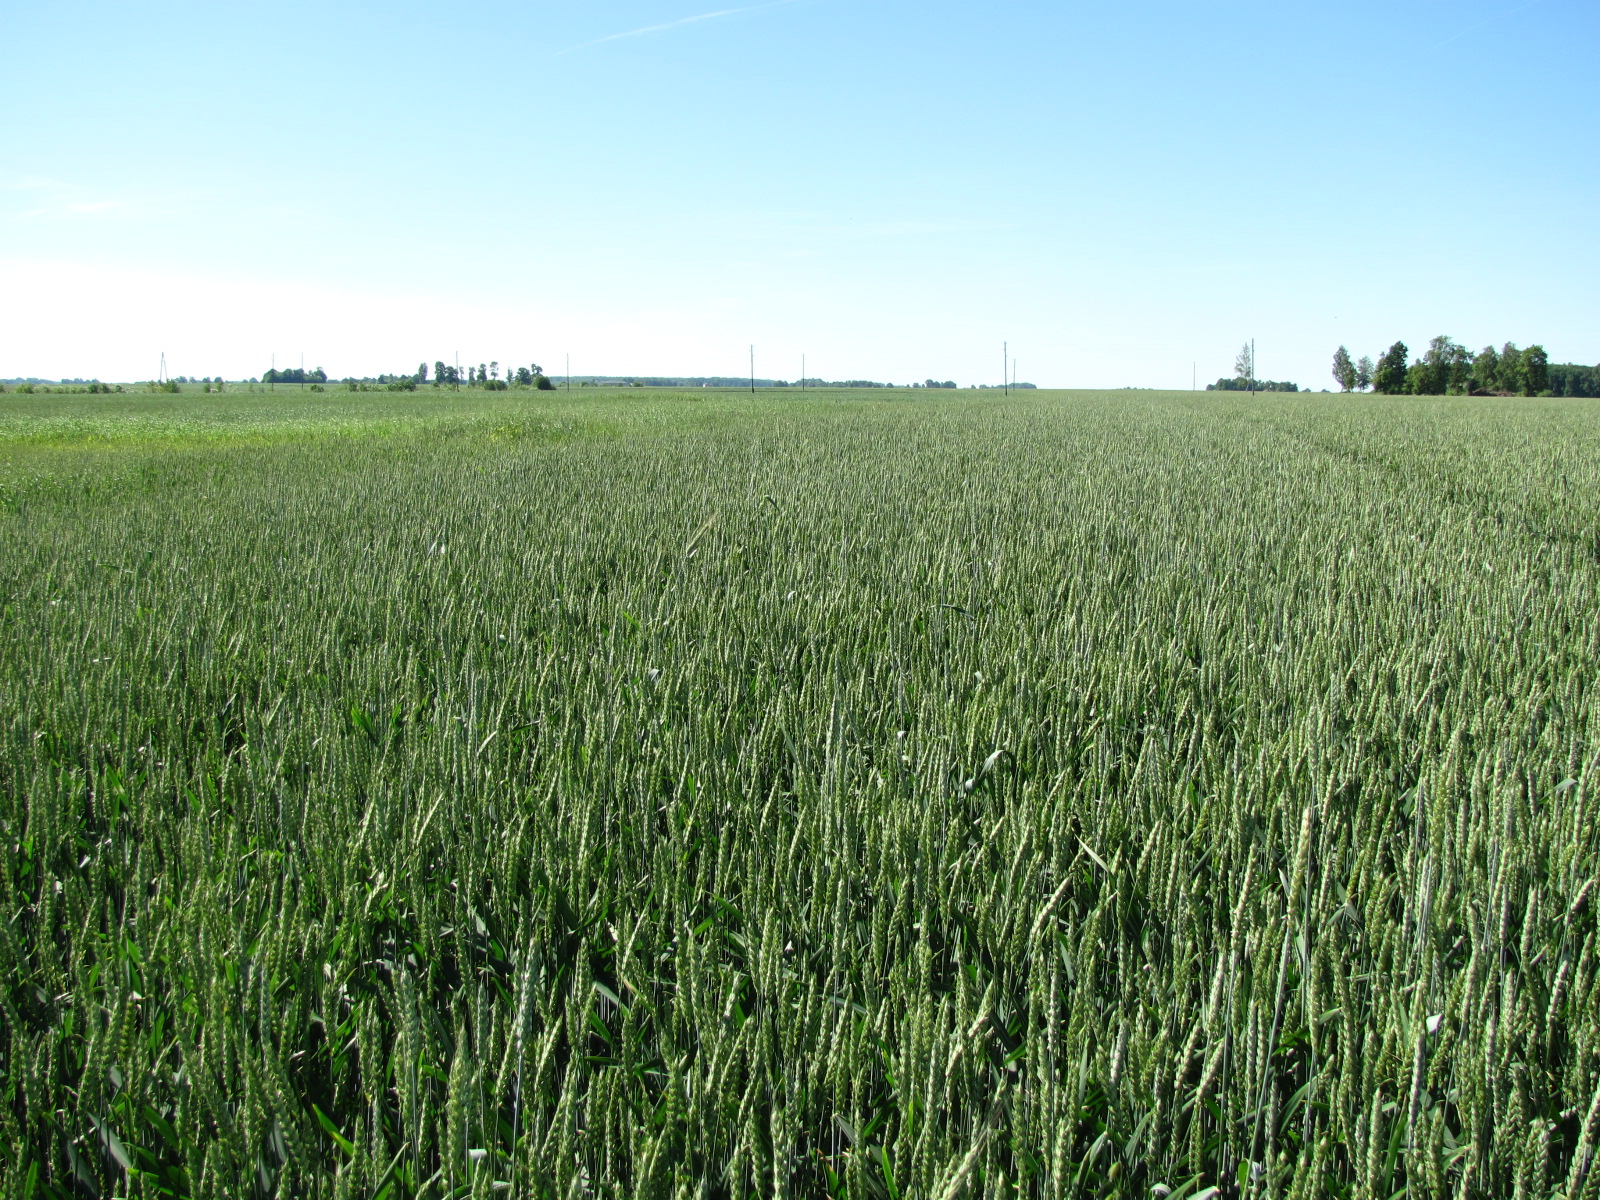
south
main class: Cropland
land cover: Common wheat
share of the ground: > 75 %
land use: Agriculture (excluding fallow land and kitchen gardens)
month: July
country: LV
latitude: 56.4964
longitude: 23.8072
